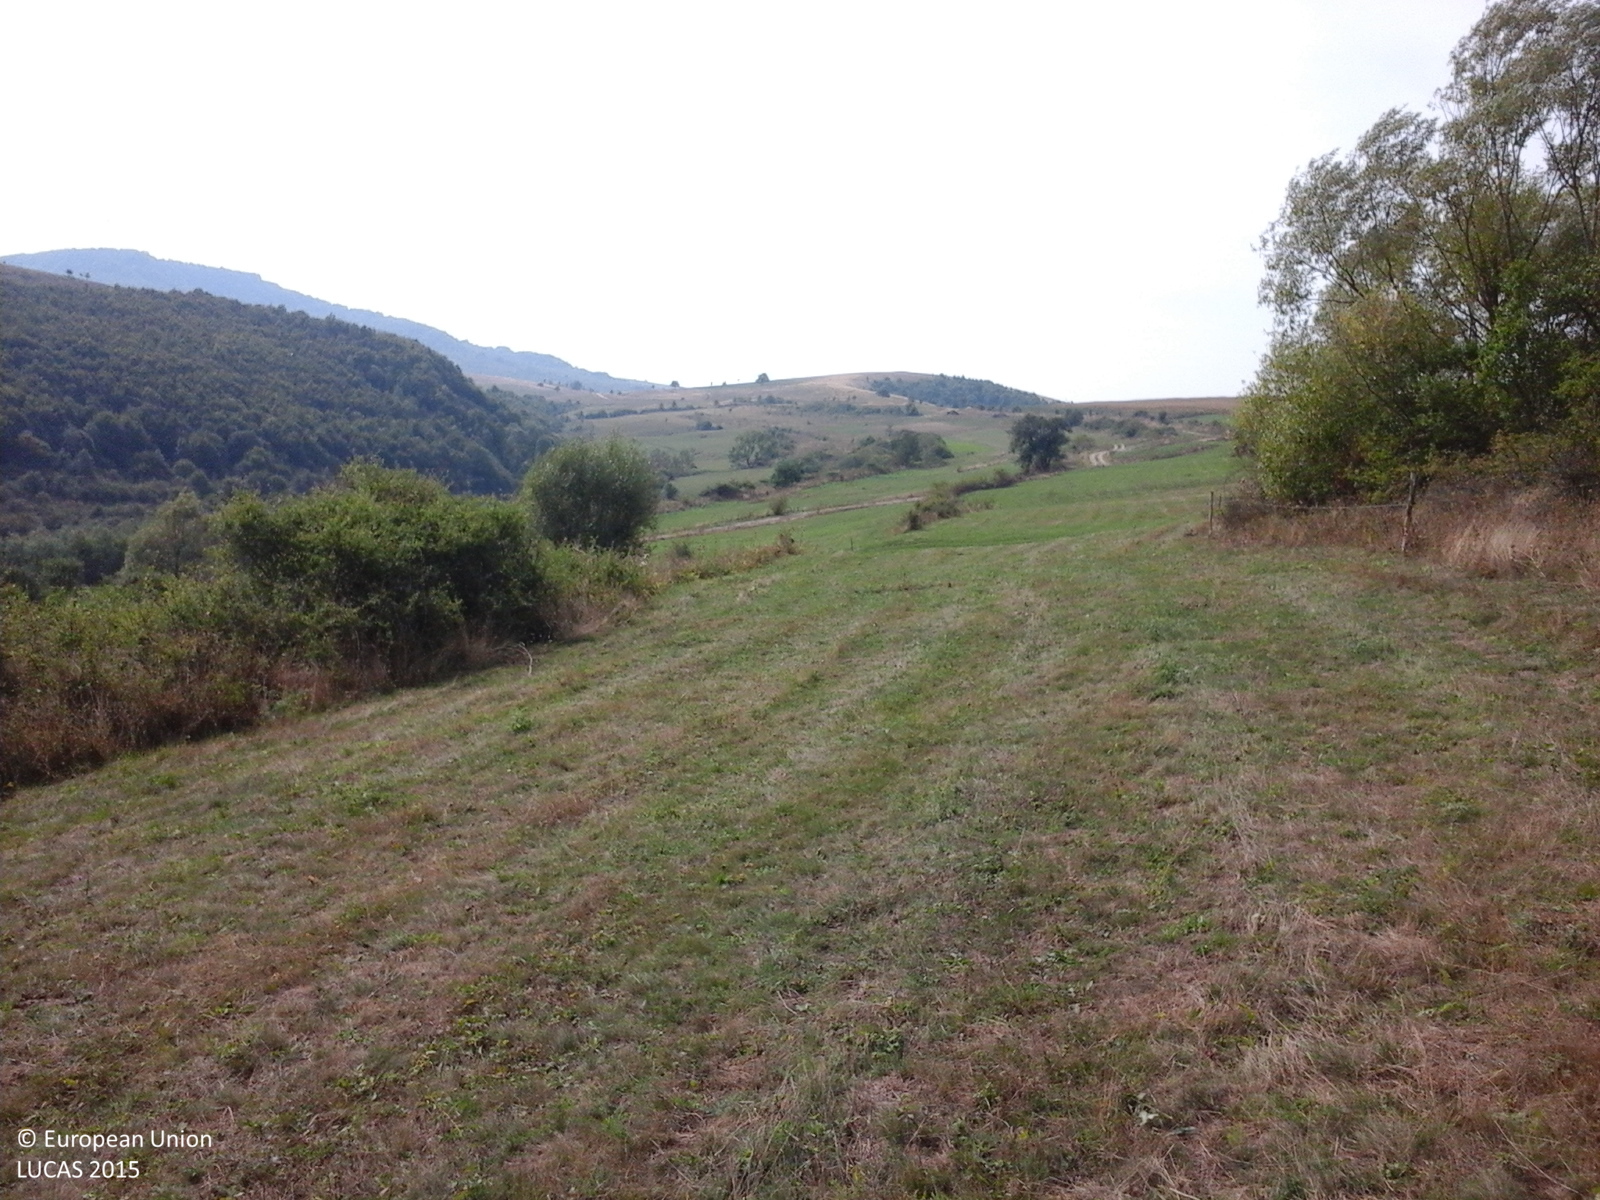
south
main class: Grassland
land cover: Grassland without tree/shrub cover
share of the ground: > 75 %
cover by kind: herbaceous plants 100 %
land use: Agriculture (excluding fallow land and kitchen gardens)
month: September
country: RO
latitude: 47.1335
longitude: 23.6405
